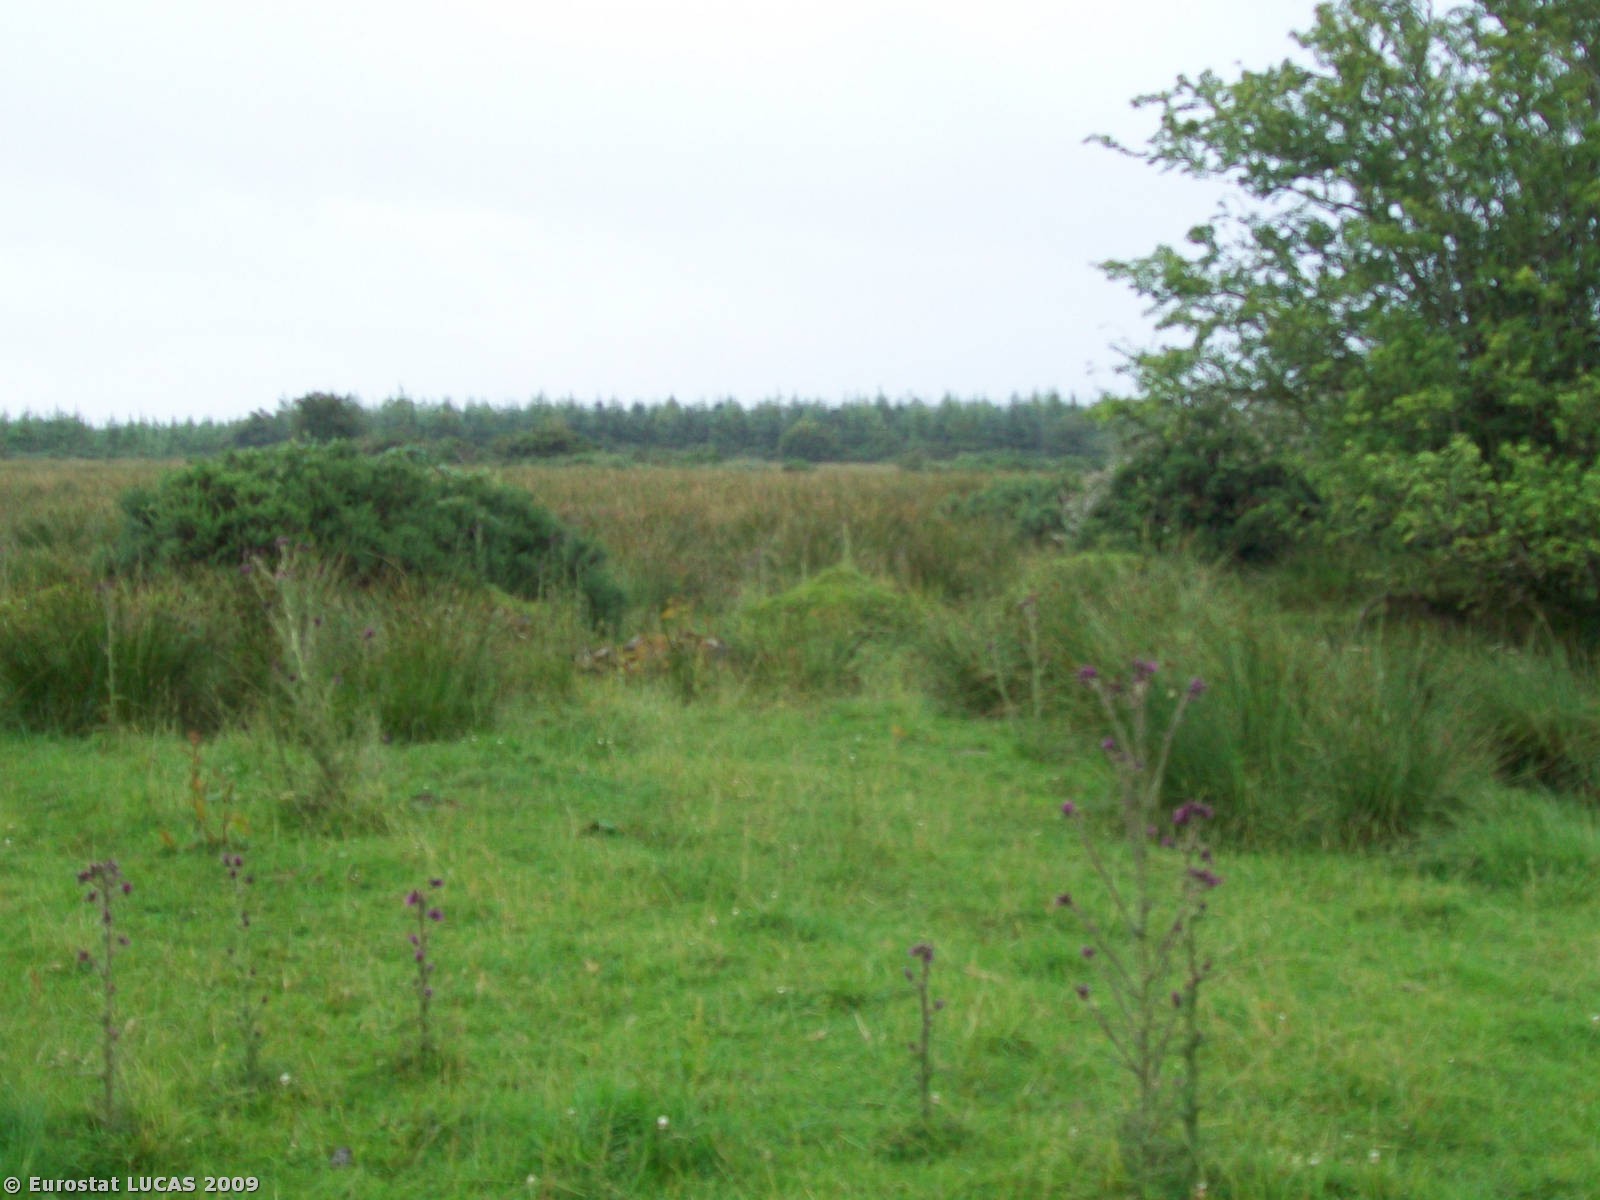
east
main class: Grassland
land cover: Grassland without tree/shrub cover
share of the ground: > 75 %
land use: Agriculture (excluding fallow land and kitchen gardens)
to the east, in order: Grassland without tree/shrub cover; Abandoned hedges; Grassland without tree/shrub cover; Abandoned hedges; Grassland without tree/shrub cover; Coniferous woodland; Grassland without tree/shrub cover
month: July
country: IE
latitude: 53.6255
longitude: -8.9439
